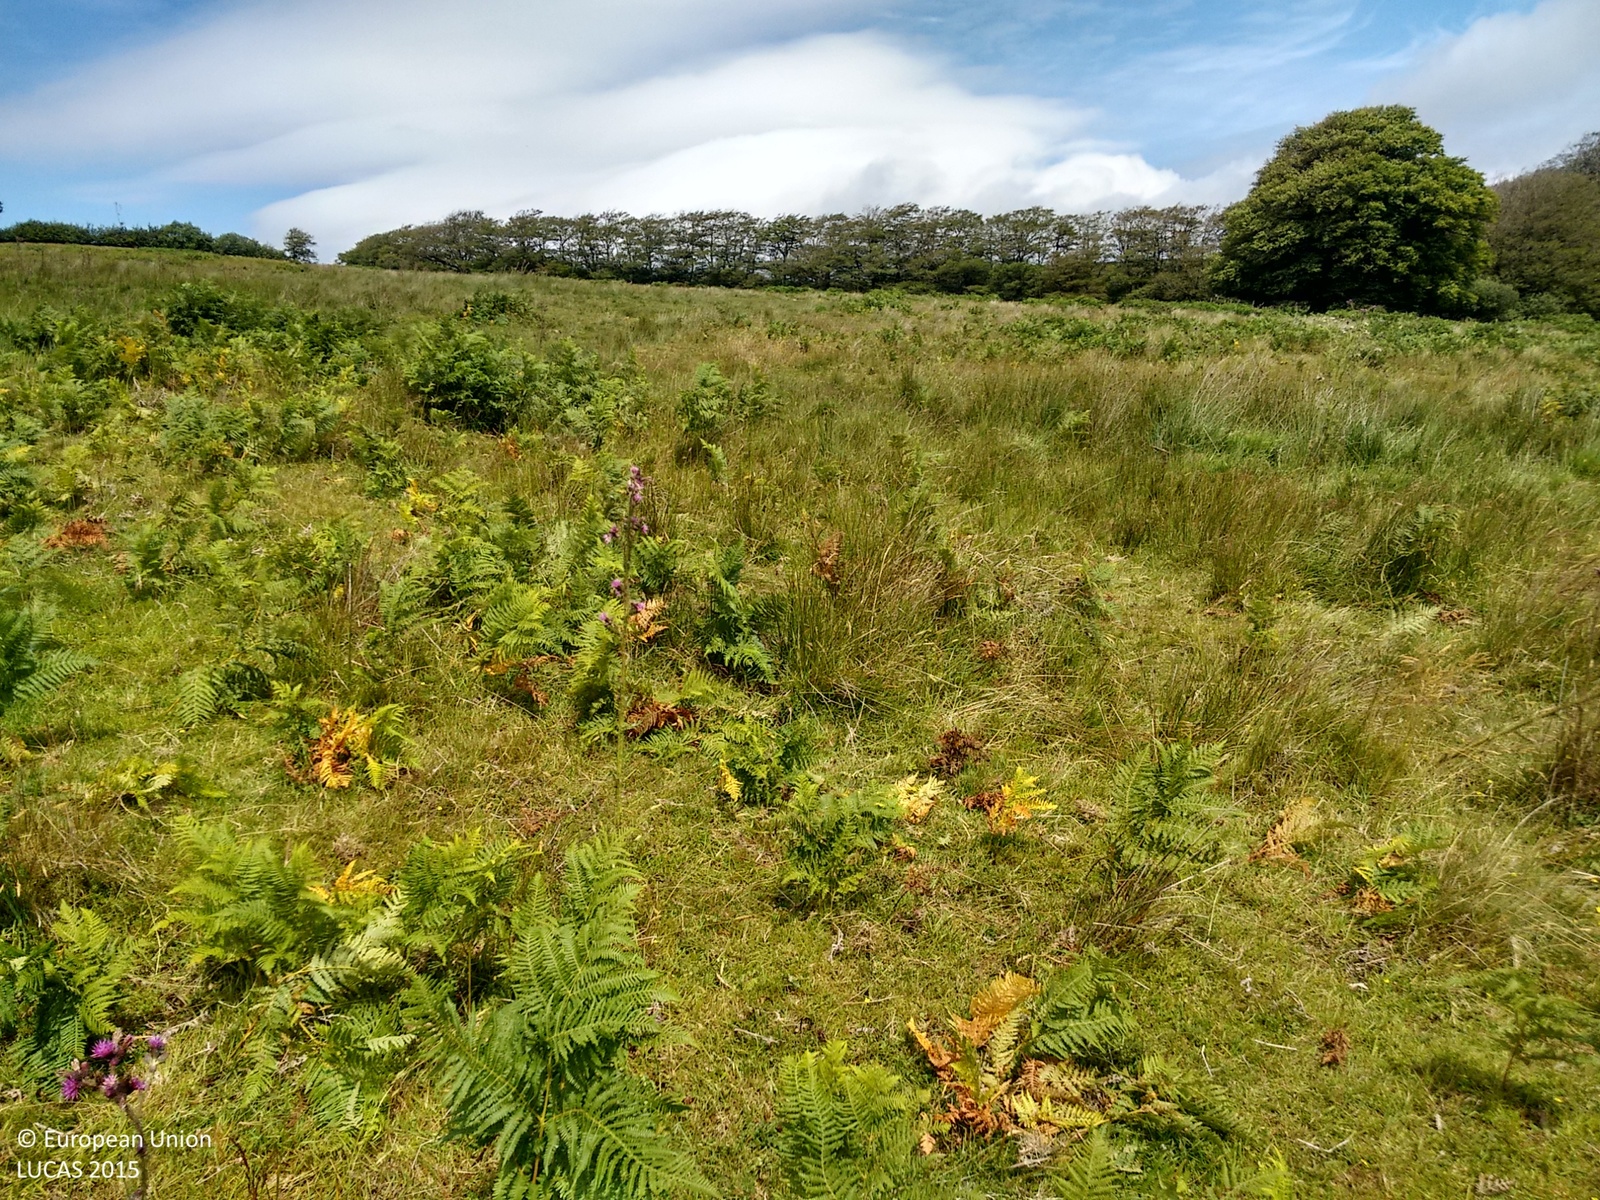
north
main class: Grassland
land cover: Grassland without tree/shrub cover
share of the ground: > 75 %
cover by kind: herbaceous plants 100 %
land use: Agriculture (excluding fallow land and kitchen gardens)
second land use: Amenities, museums, leisure
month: July
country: GB
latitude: 51.1558
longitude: -3.5684
